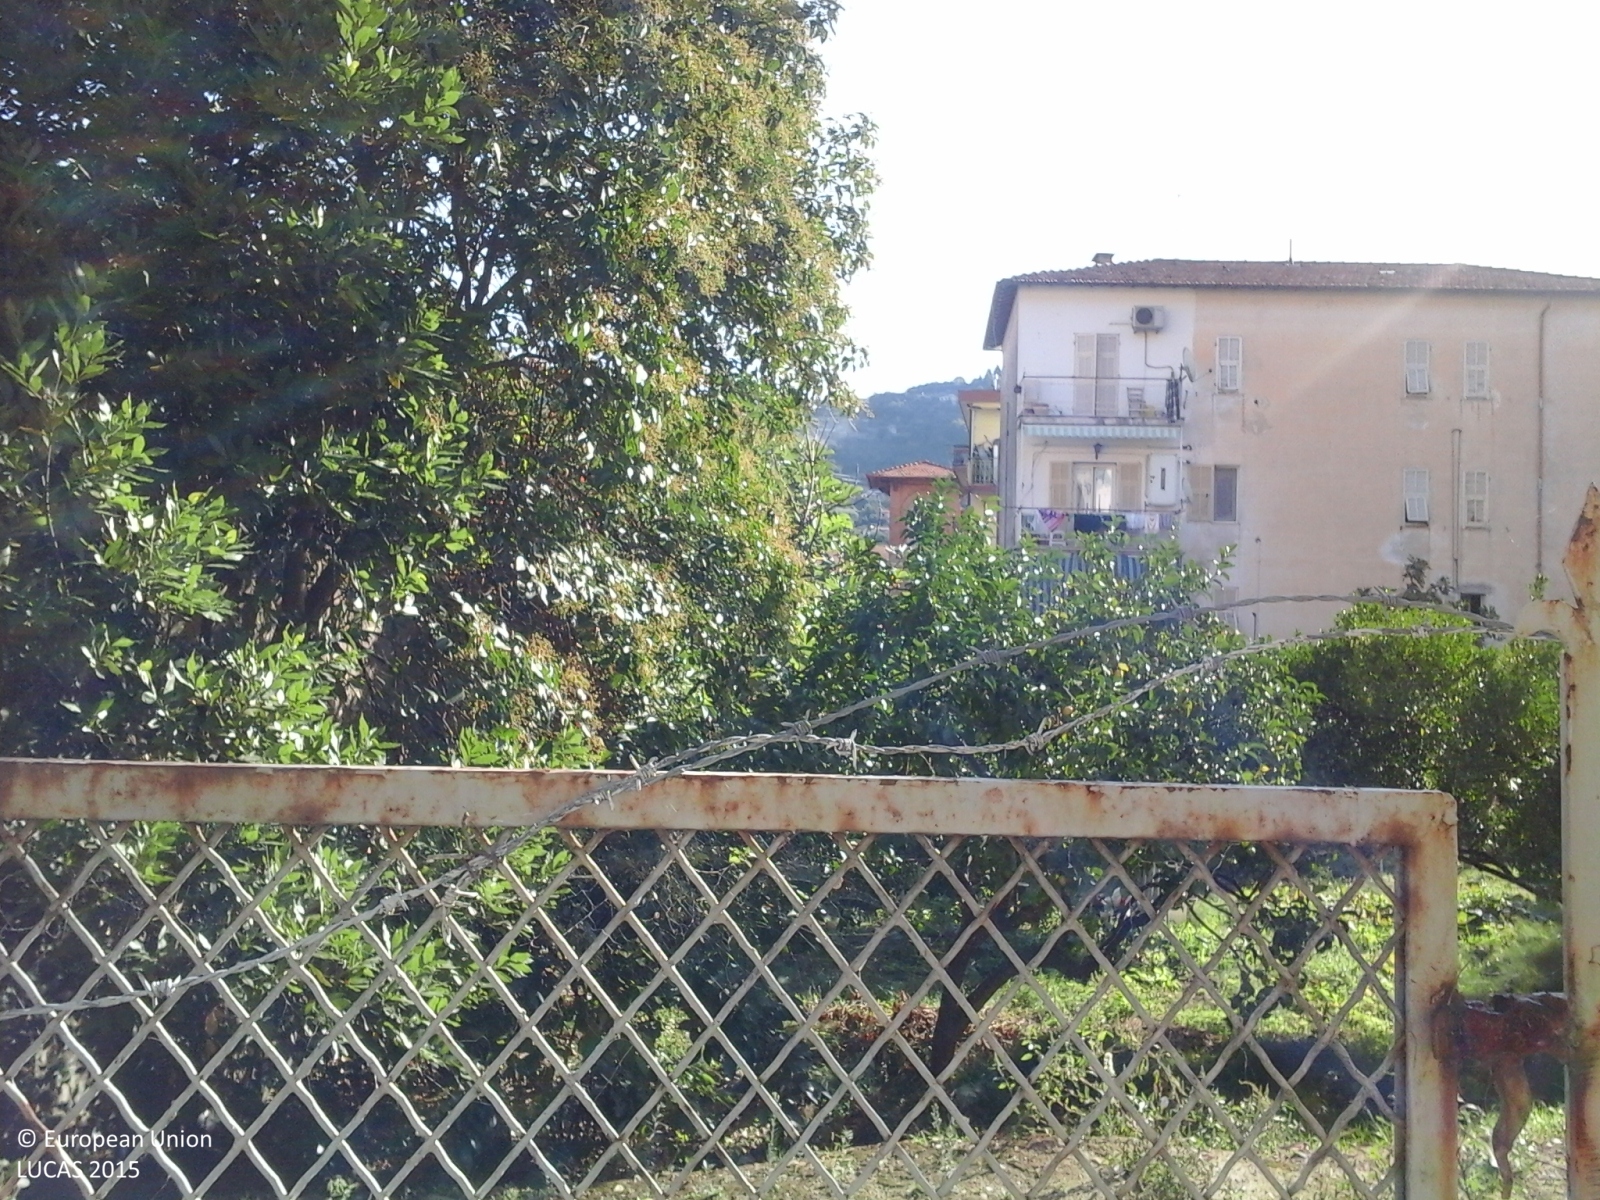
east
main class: Cropland
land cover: Other citrus fruit
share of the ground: 50 - 75 %
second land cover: Grassland without tree/shrub cover
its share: 50 - 75 %
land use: Kitchen garden
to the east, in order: Other citrus fruit; Grassland without tree/shrub cover; Artificial constructions in urban areas; Grass margins; Inland fresh running water; Grass margins
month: October
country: IT
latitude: 43.8592
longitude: 7.8529
